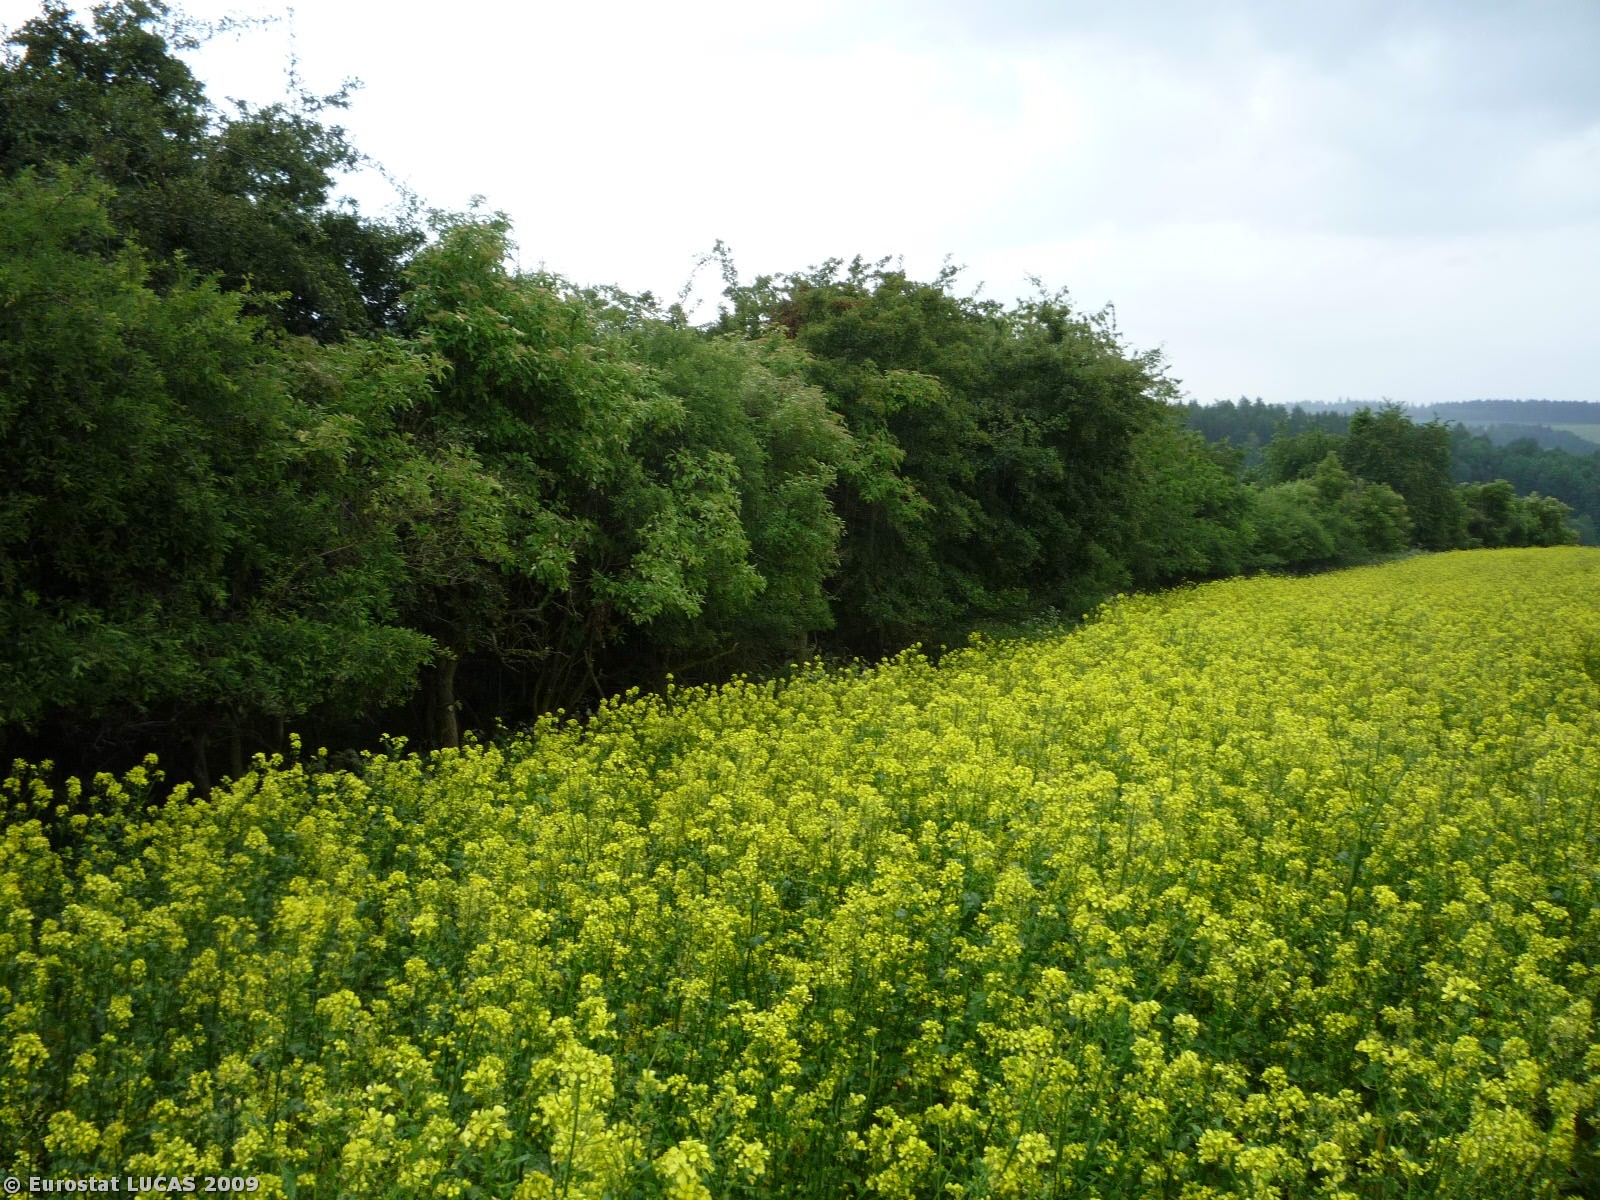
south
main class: Cropland
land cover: Other fibre and oleaginous crops
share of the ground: > 75 %
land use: Agriculture (excluding fallow land and kitchen gardens)
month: June
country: CZ
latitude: 49.9531
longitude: 14.8945
